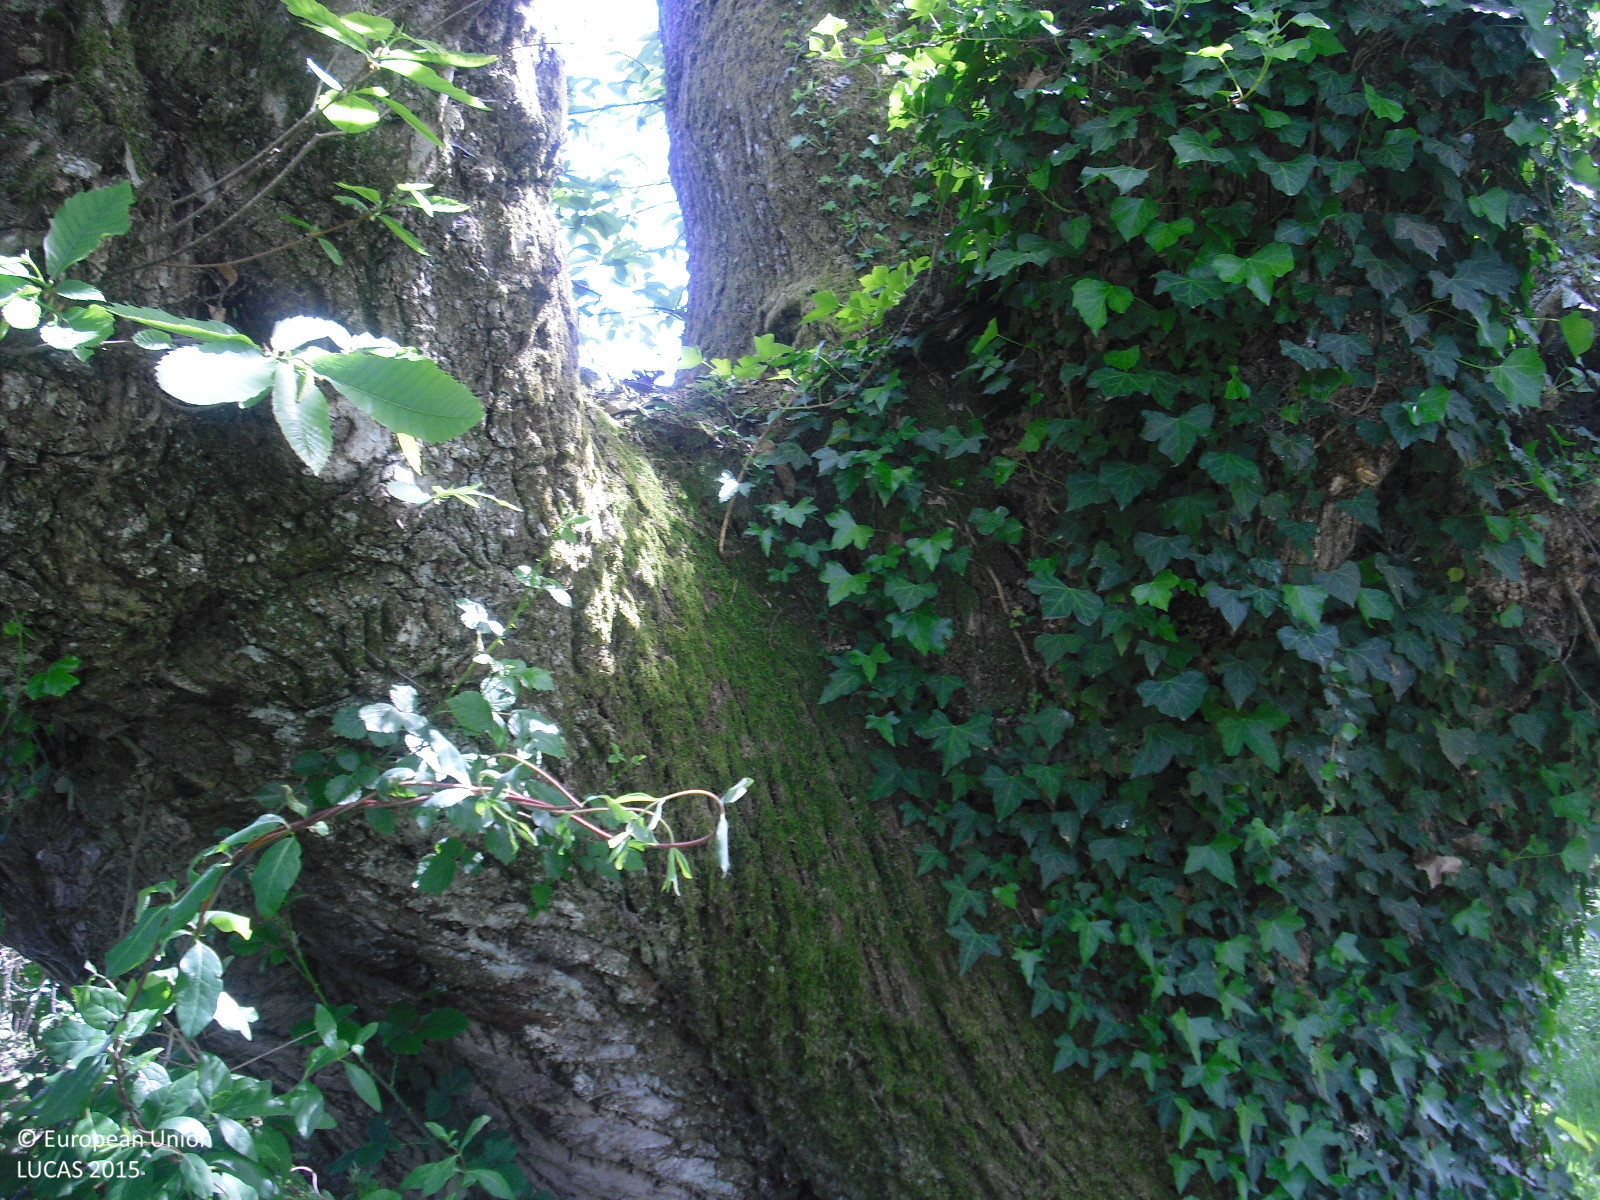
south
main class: Cropland
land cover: Nuts trees
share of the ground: > 75 %
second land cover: Spontaneously vegetated surfaces
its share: > 75 %
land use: Agriculture (excluding fallow land and kitchen gardens)
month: May
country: ES
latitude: 41.9022
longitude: -7.3305
